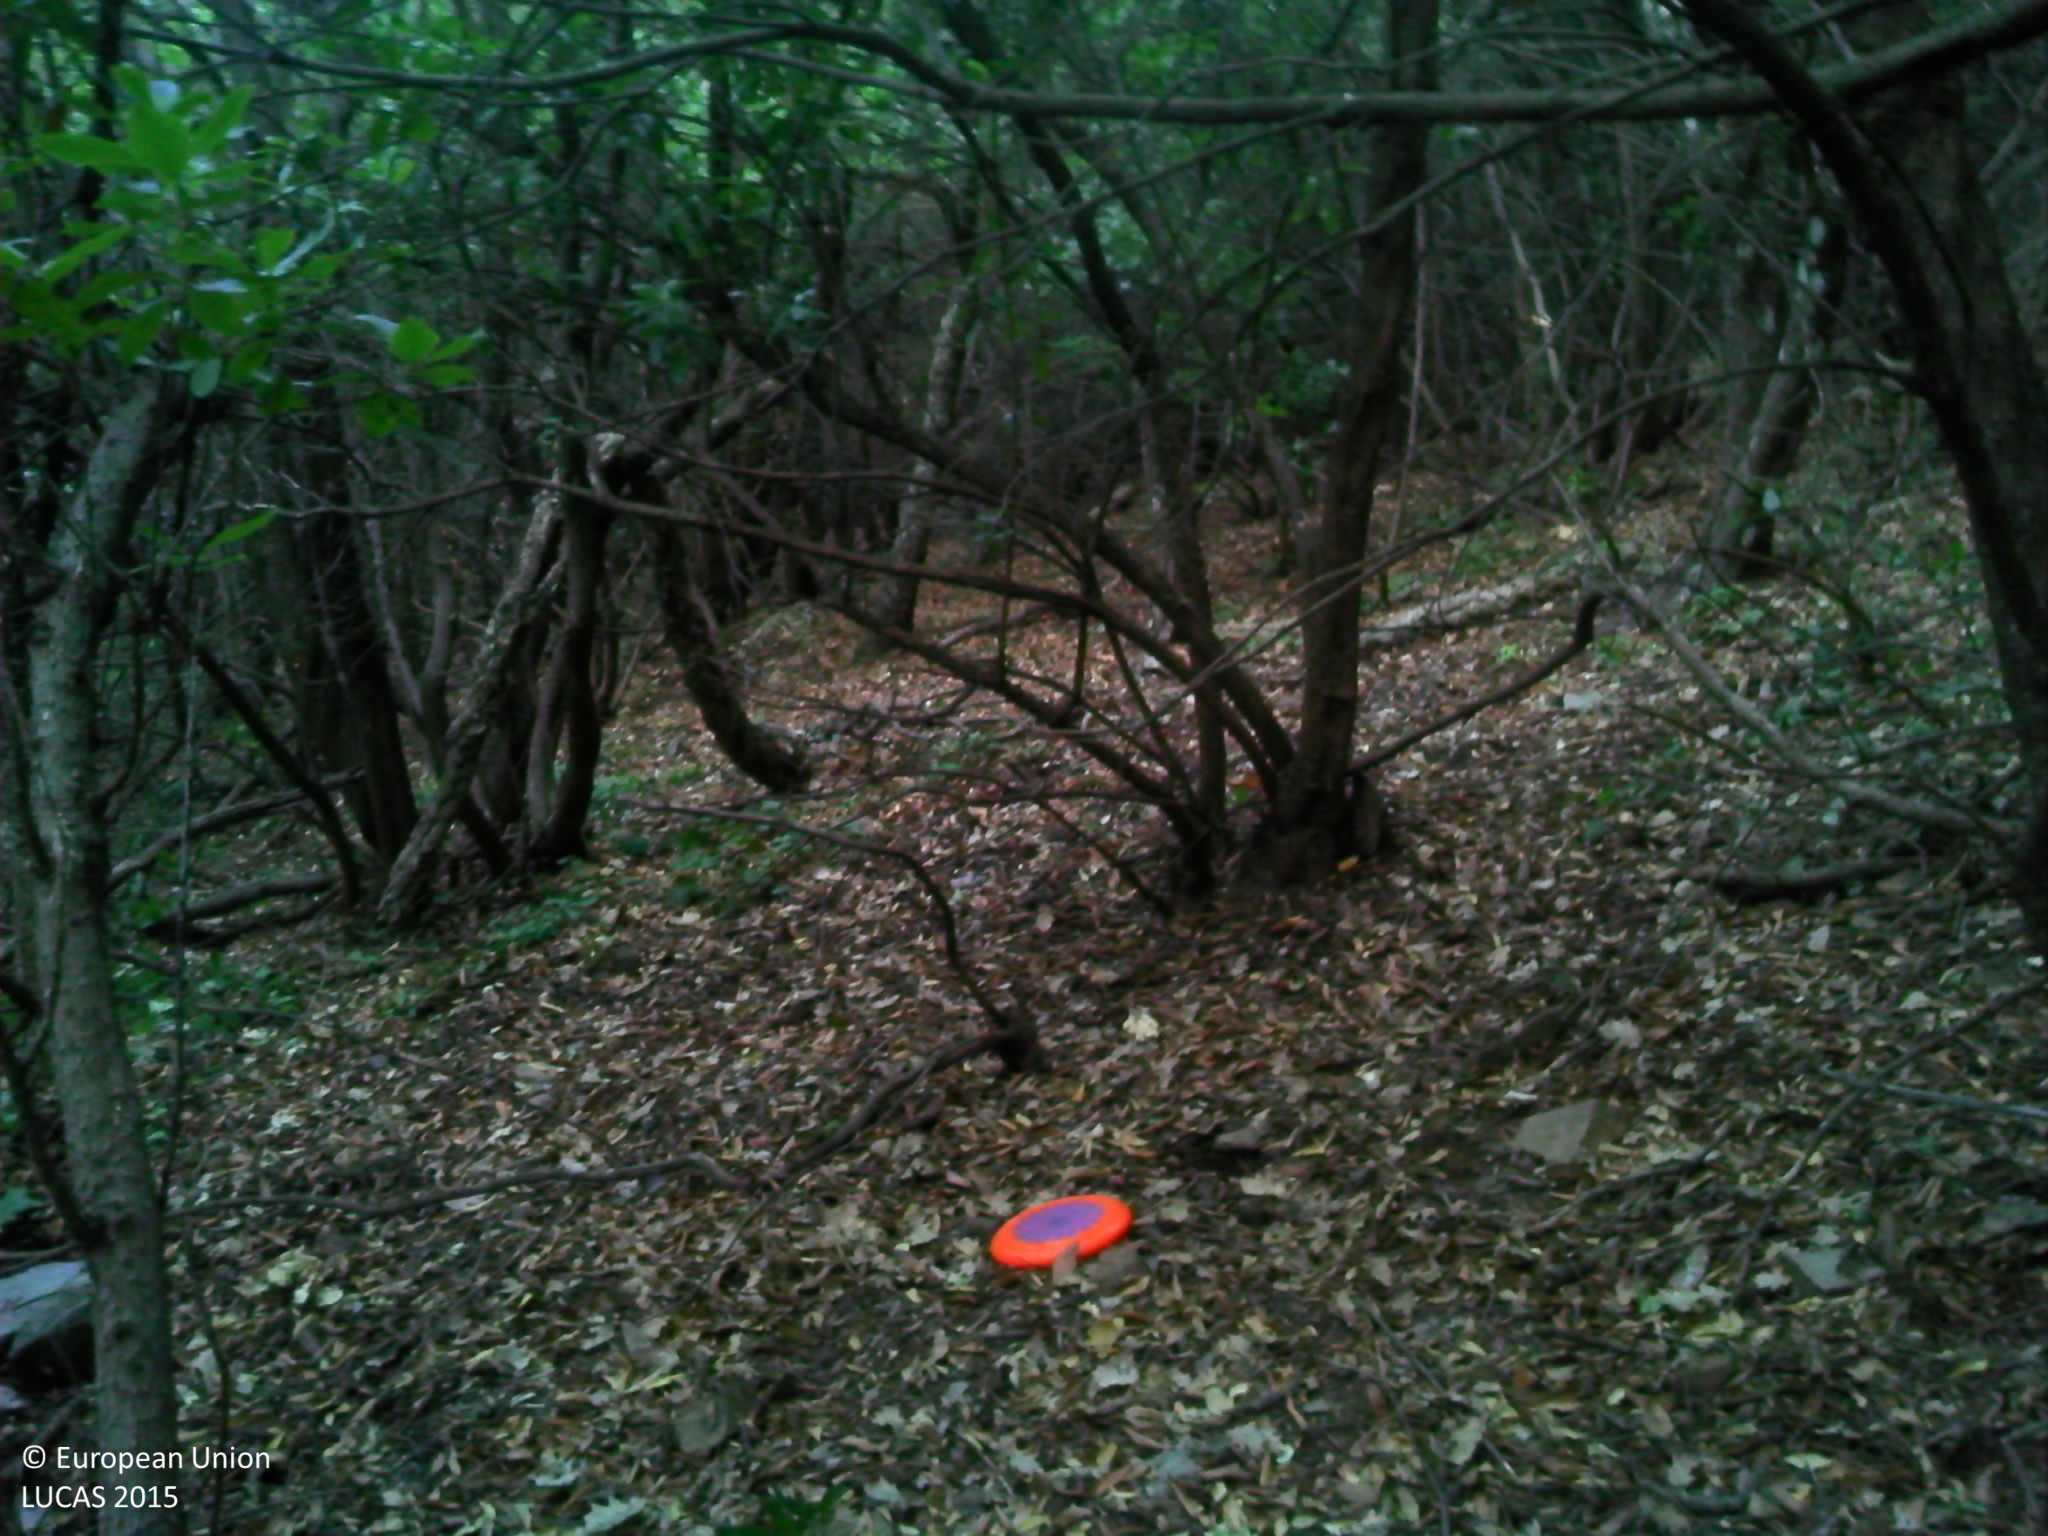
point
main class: Woodland
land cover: Broadleaved woodland
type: broadleaved evergreen forest
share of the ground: > 75 %
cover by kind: broadleaved forest trees 80 %, shrubs 20 %
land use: Semi-natural and natural areas not in use
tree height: > 5 m
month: July
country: FR
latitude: 43.2732
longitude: 6.3006
